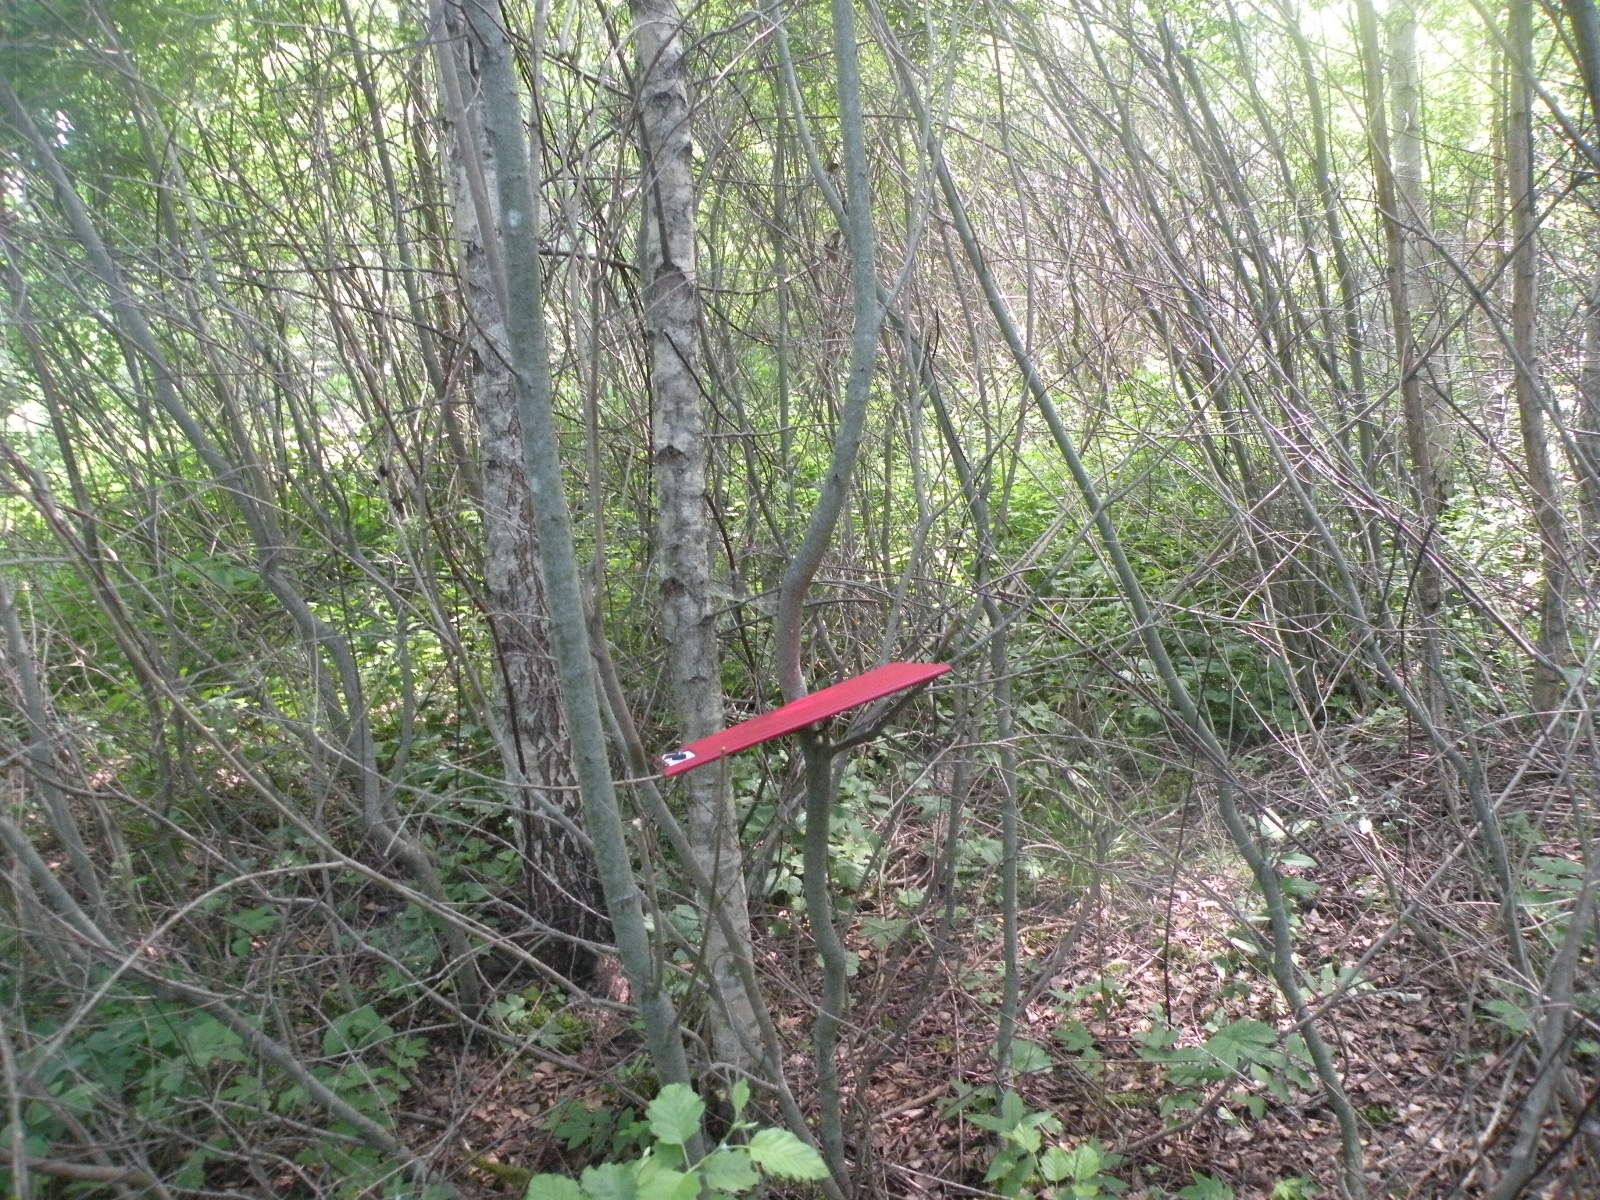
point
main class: Woodland
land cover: Broadleaved woodland
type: non-riverine alder, birch or aspen forest
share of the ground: > 75 %
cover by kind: broadleaved forest trees 80 %, shrubs 10 %, herbaceous plants 10 %
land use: Forestry
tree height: > 5 m
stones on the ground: < 10 %
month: June
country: LV
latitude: 55.9053
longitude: 27.0095
